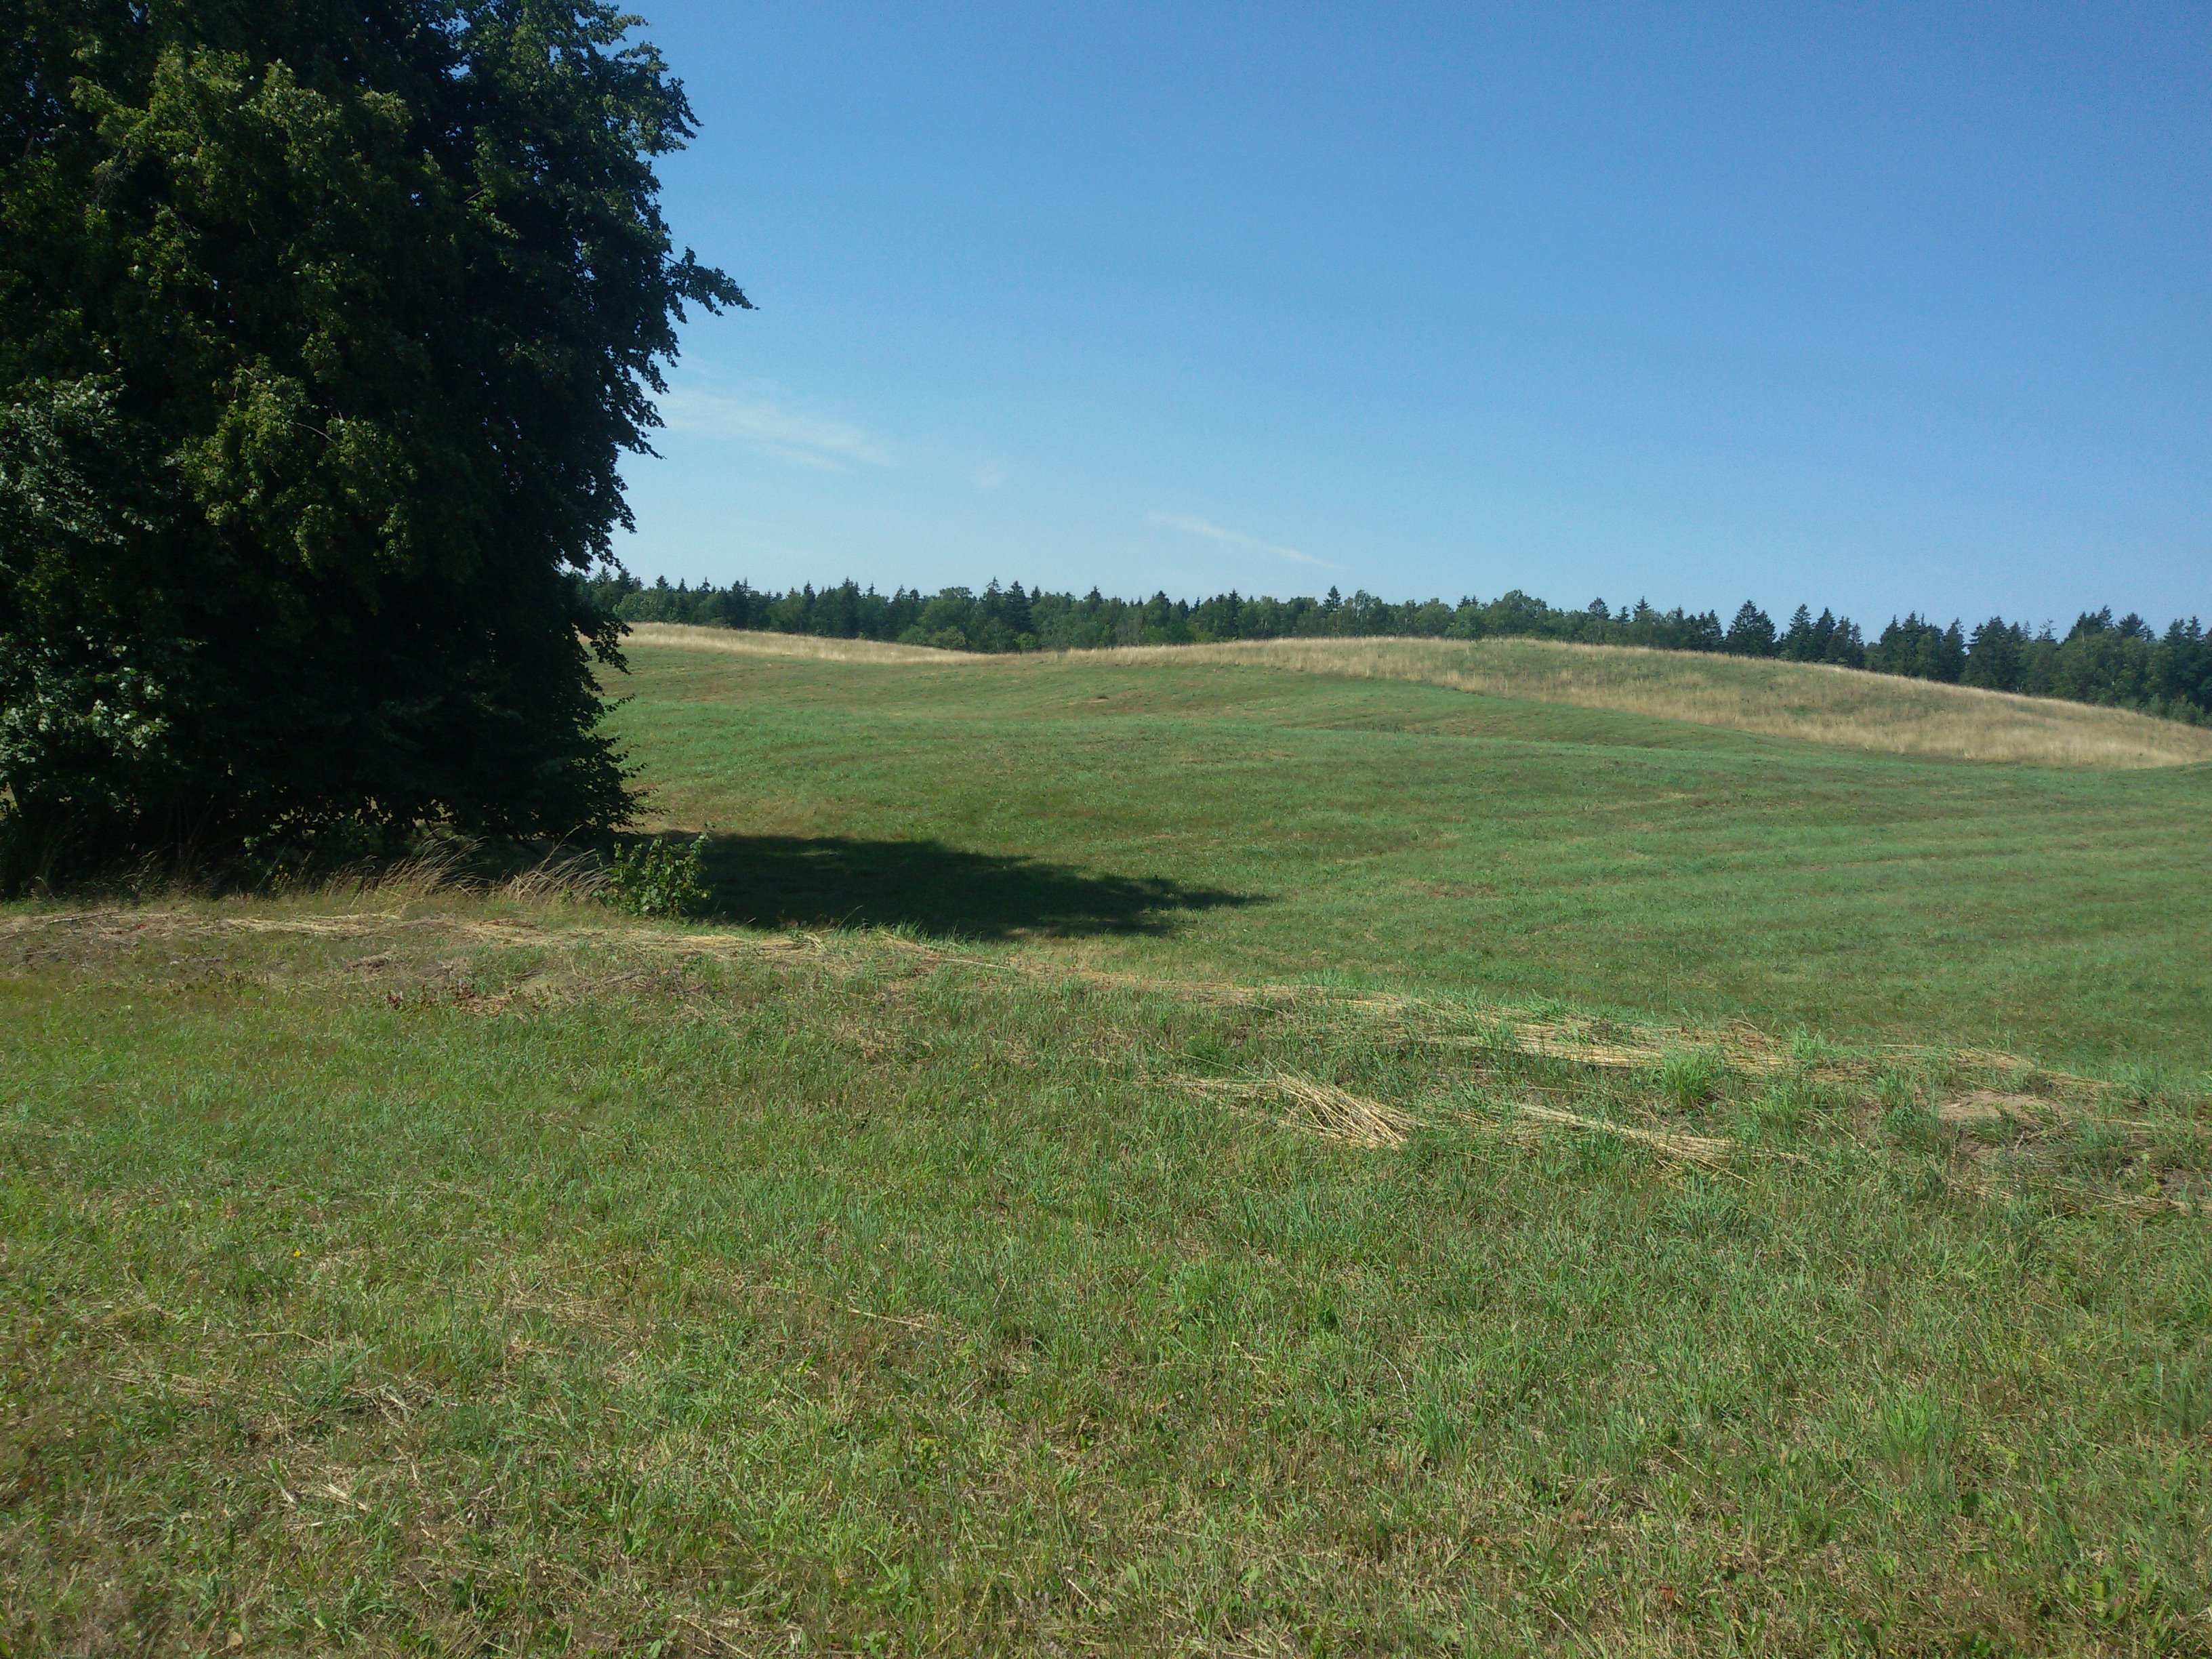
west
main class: Grassland
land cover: Grassland without tree/shrub cover
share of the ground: > 75 %
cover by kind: herbaceous plants 100 %
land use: Agriculture (excluding fallow land and kitchen gardens)
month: August
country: PL
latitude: 53.8852
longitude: 21.1354
